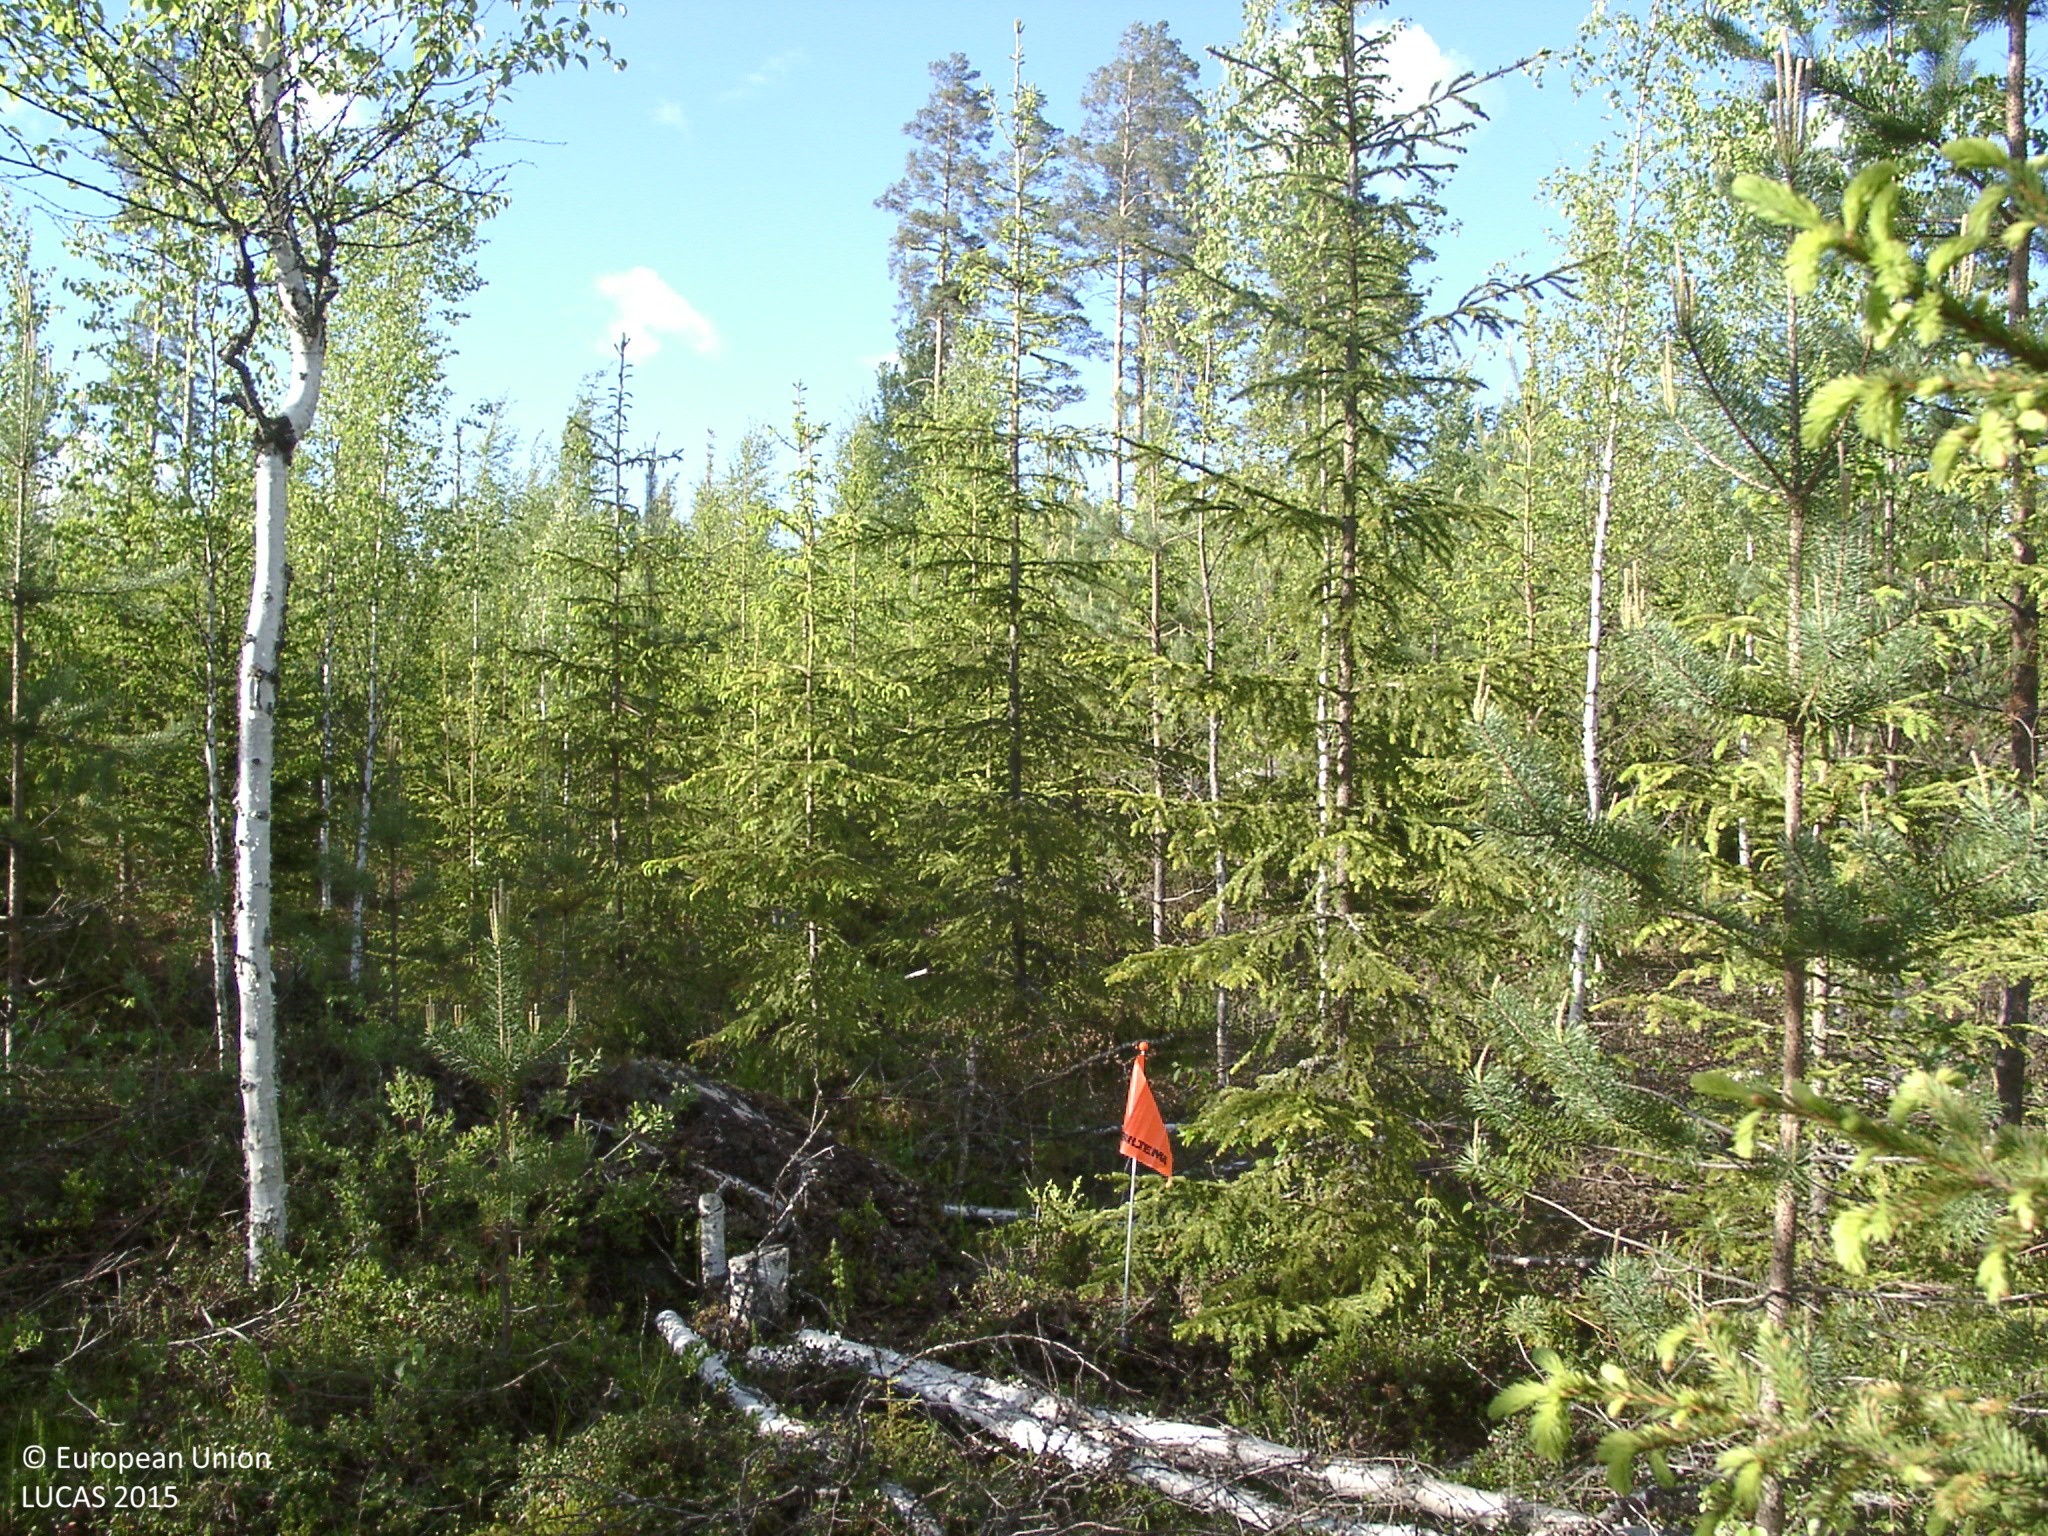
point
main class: Woodland
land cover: Other mixed woodland
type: boreal forest
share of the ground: 25 - 50 %
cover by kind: coniferous forest trees 30 %, shrubs 25 %, broadleaved forest trees 10 %, lichens and mosses 10 %, herbaceous plants 5 %
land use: Forestry
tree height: < 5 m
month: June
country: FI
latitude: 61.7371
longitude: 24.8899
